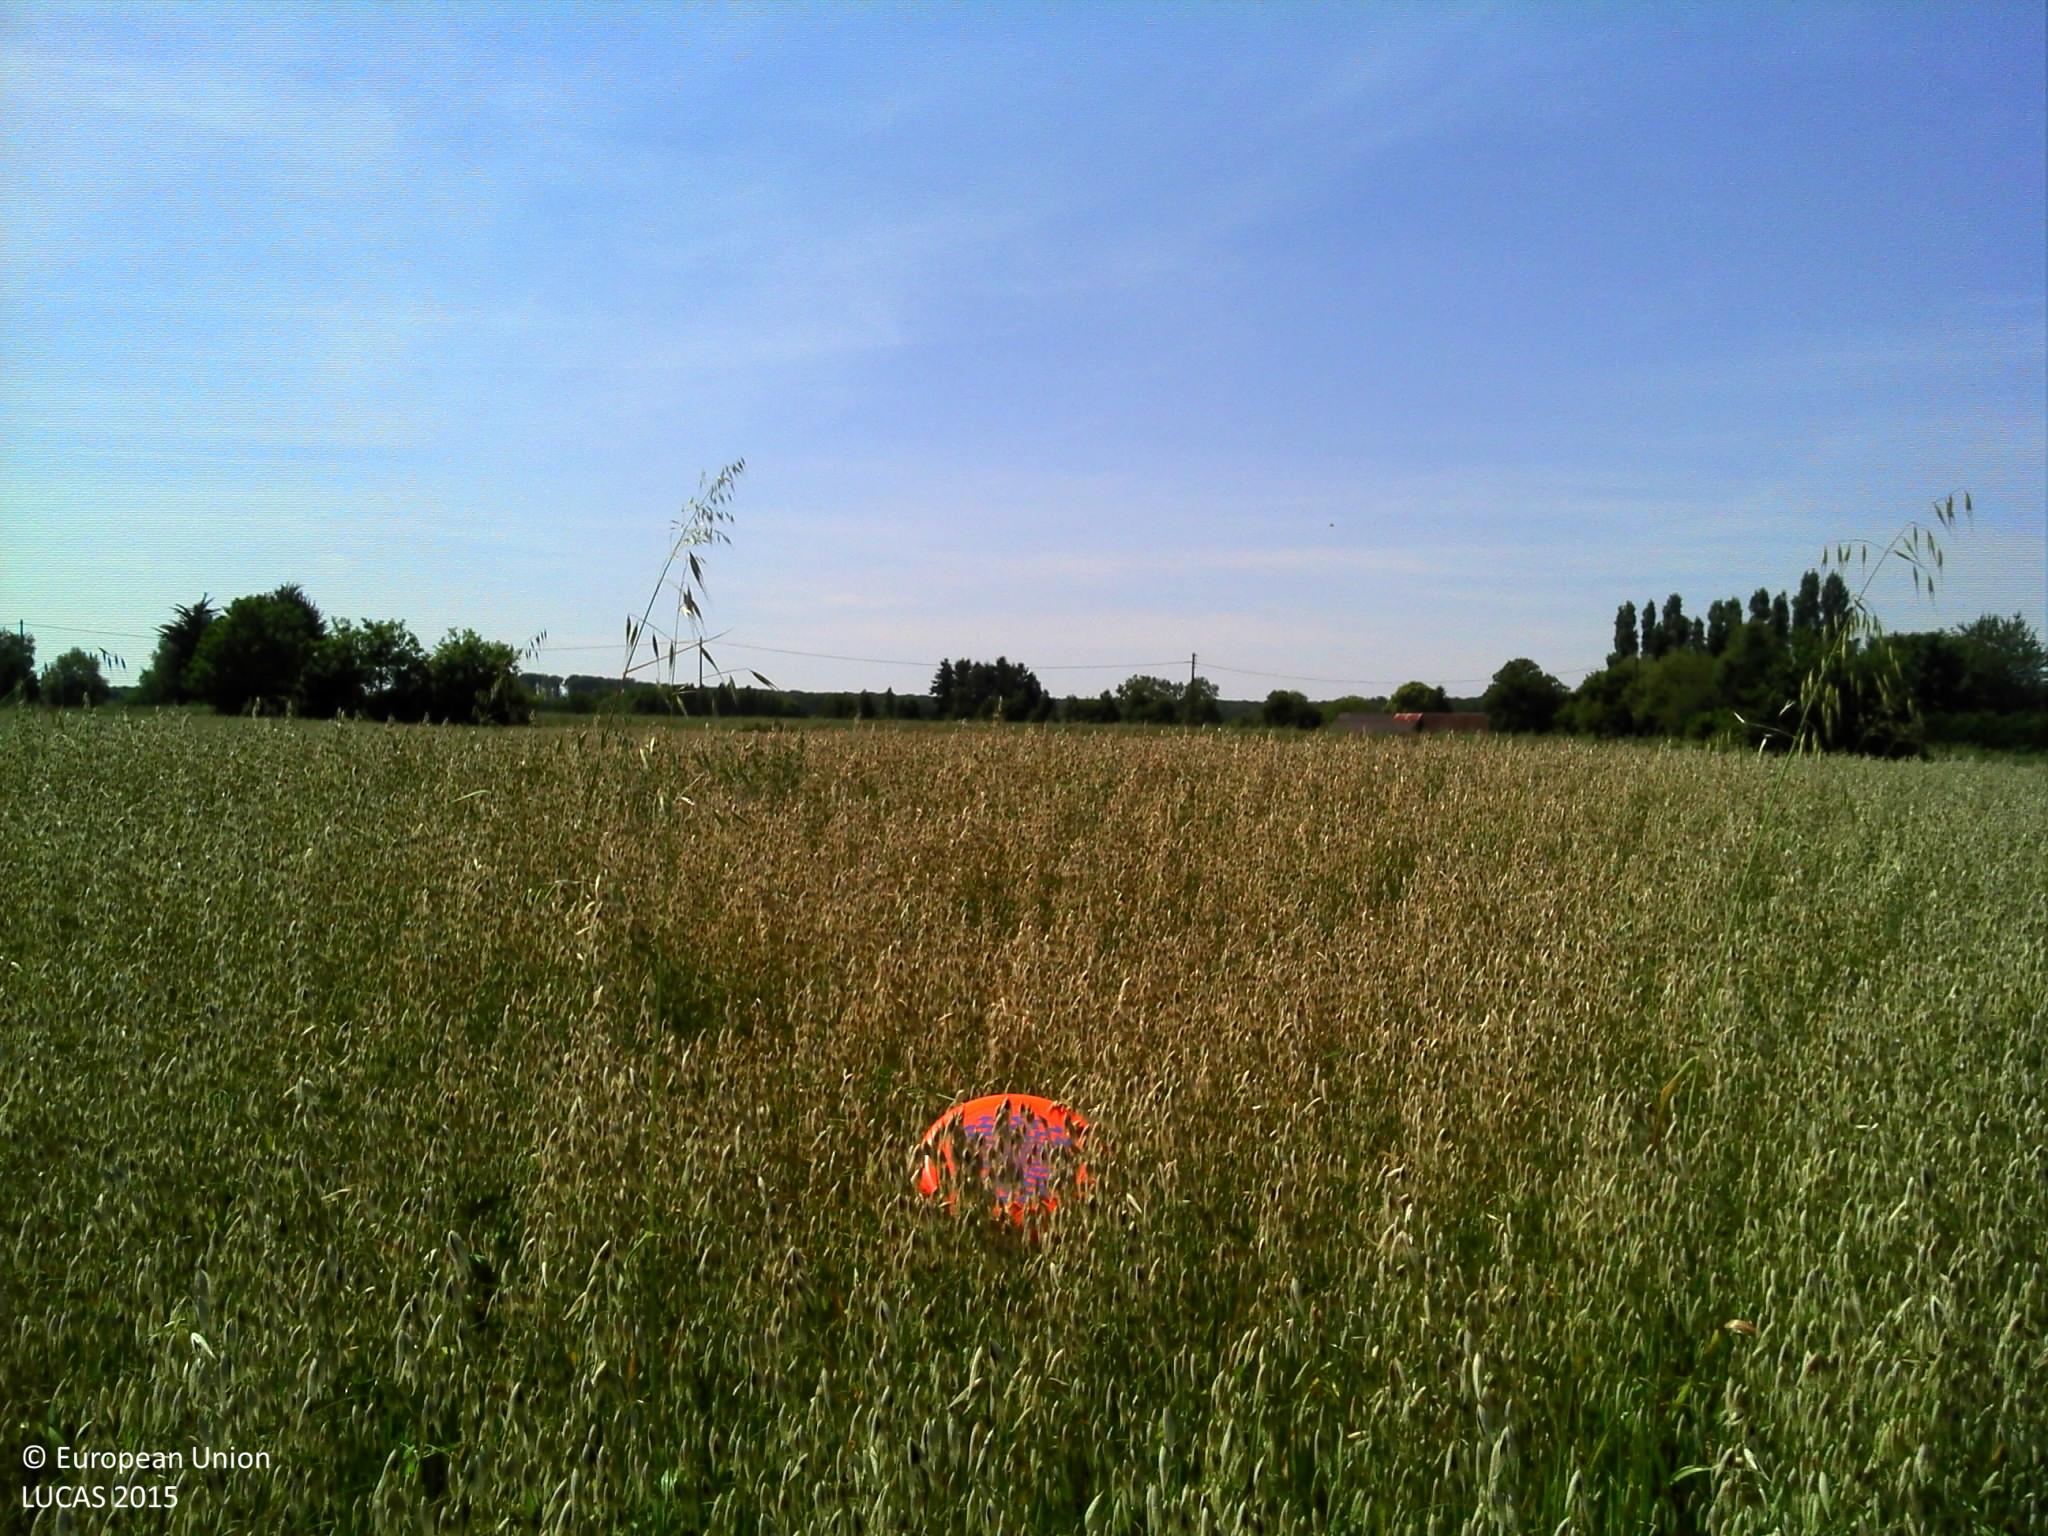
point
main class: Cropland
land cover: Oats
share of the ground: > 75 %
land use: Agriculture (excluding fallow land and kitchen gardens)
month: June
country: FR
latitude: 48.3695
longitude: 0.2403
